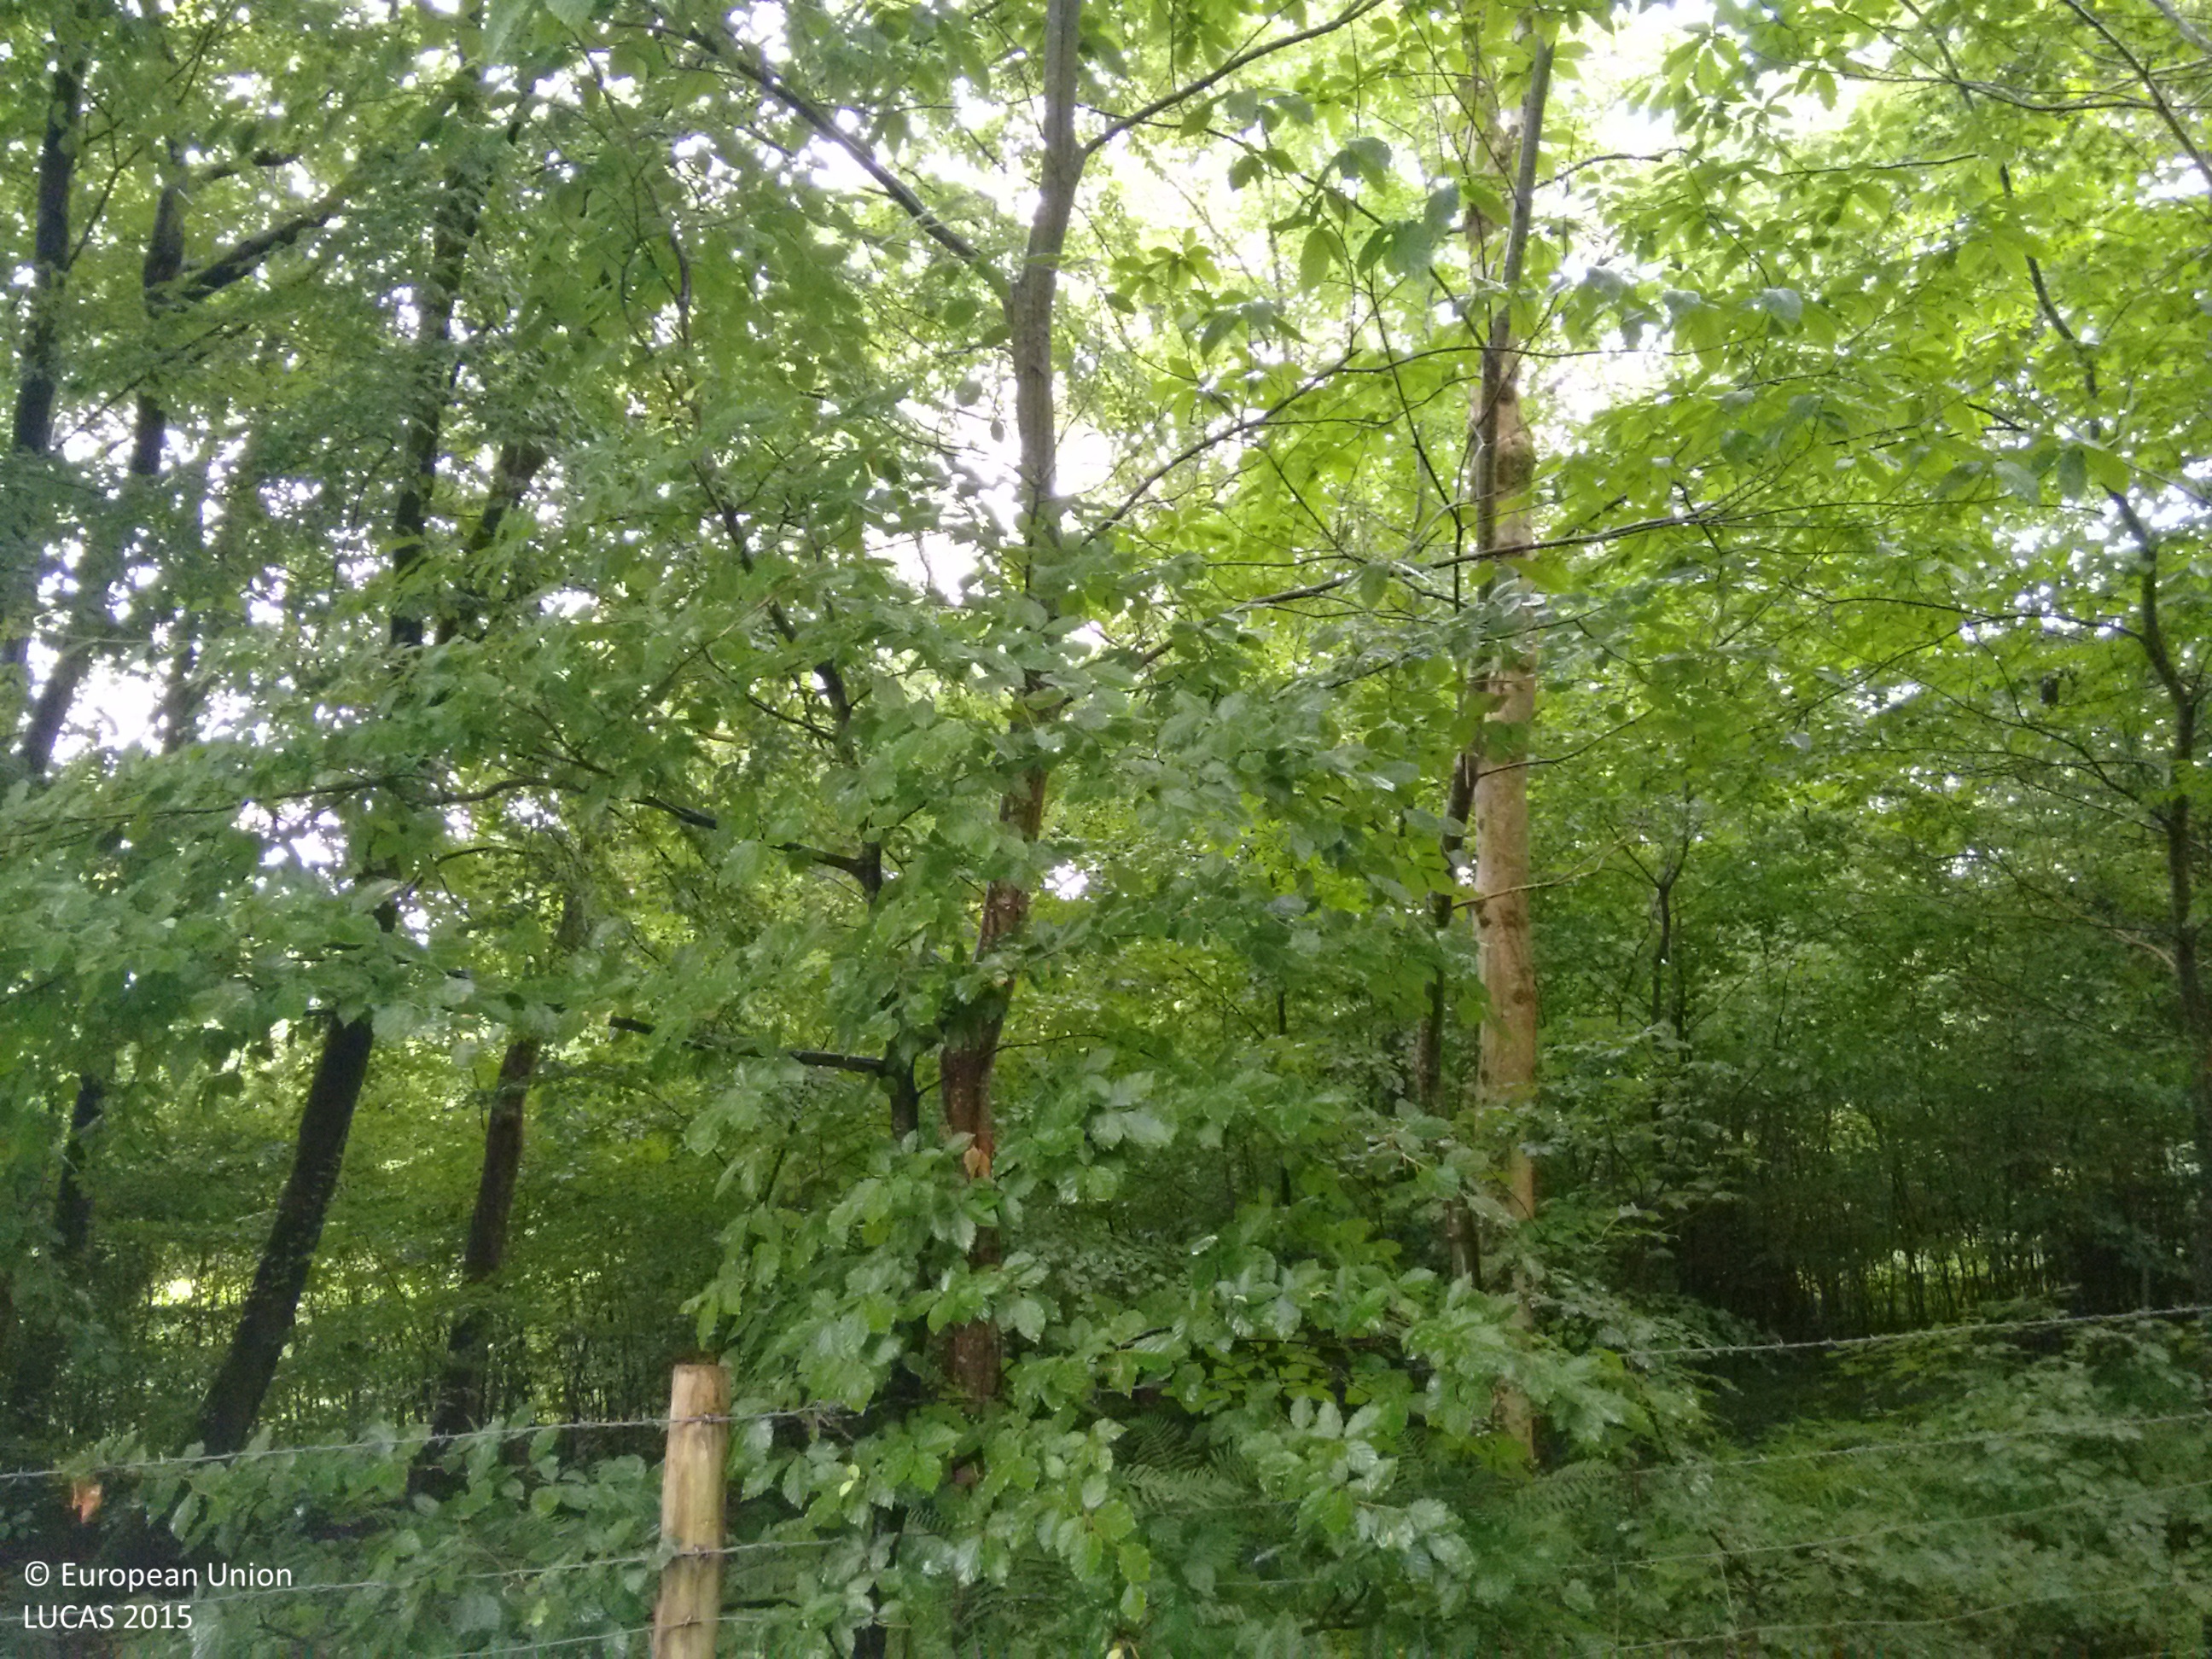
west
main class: Woodland
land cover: Broadleaved woodland
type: mesophytic deciduous forest
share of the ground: > 75 %
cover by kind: broadleaved forest trees 100 %
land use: Residential
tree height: > 5 m
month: July
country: GB
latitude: 51.0325
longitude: -3.5317
